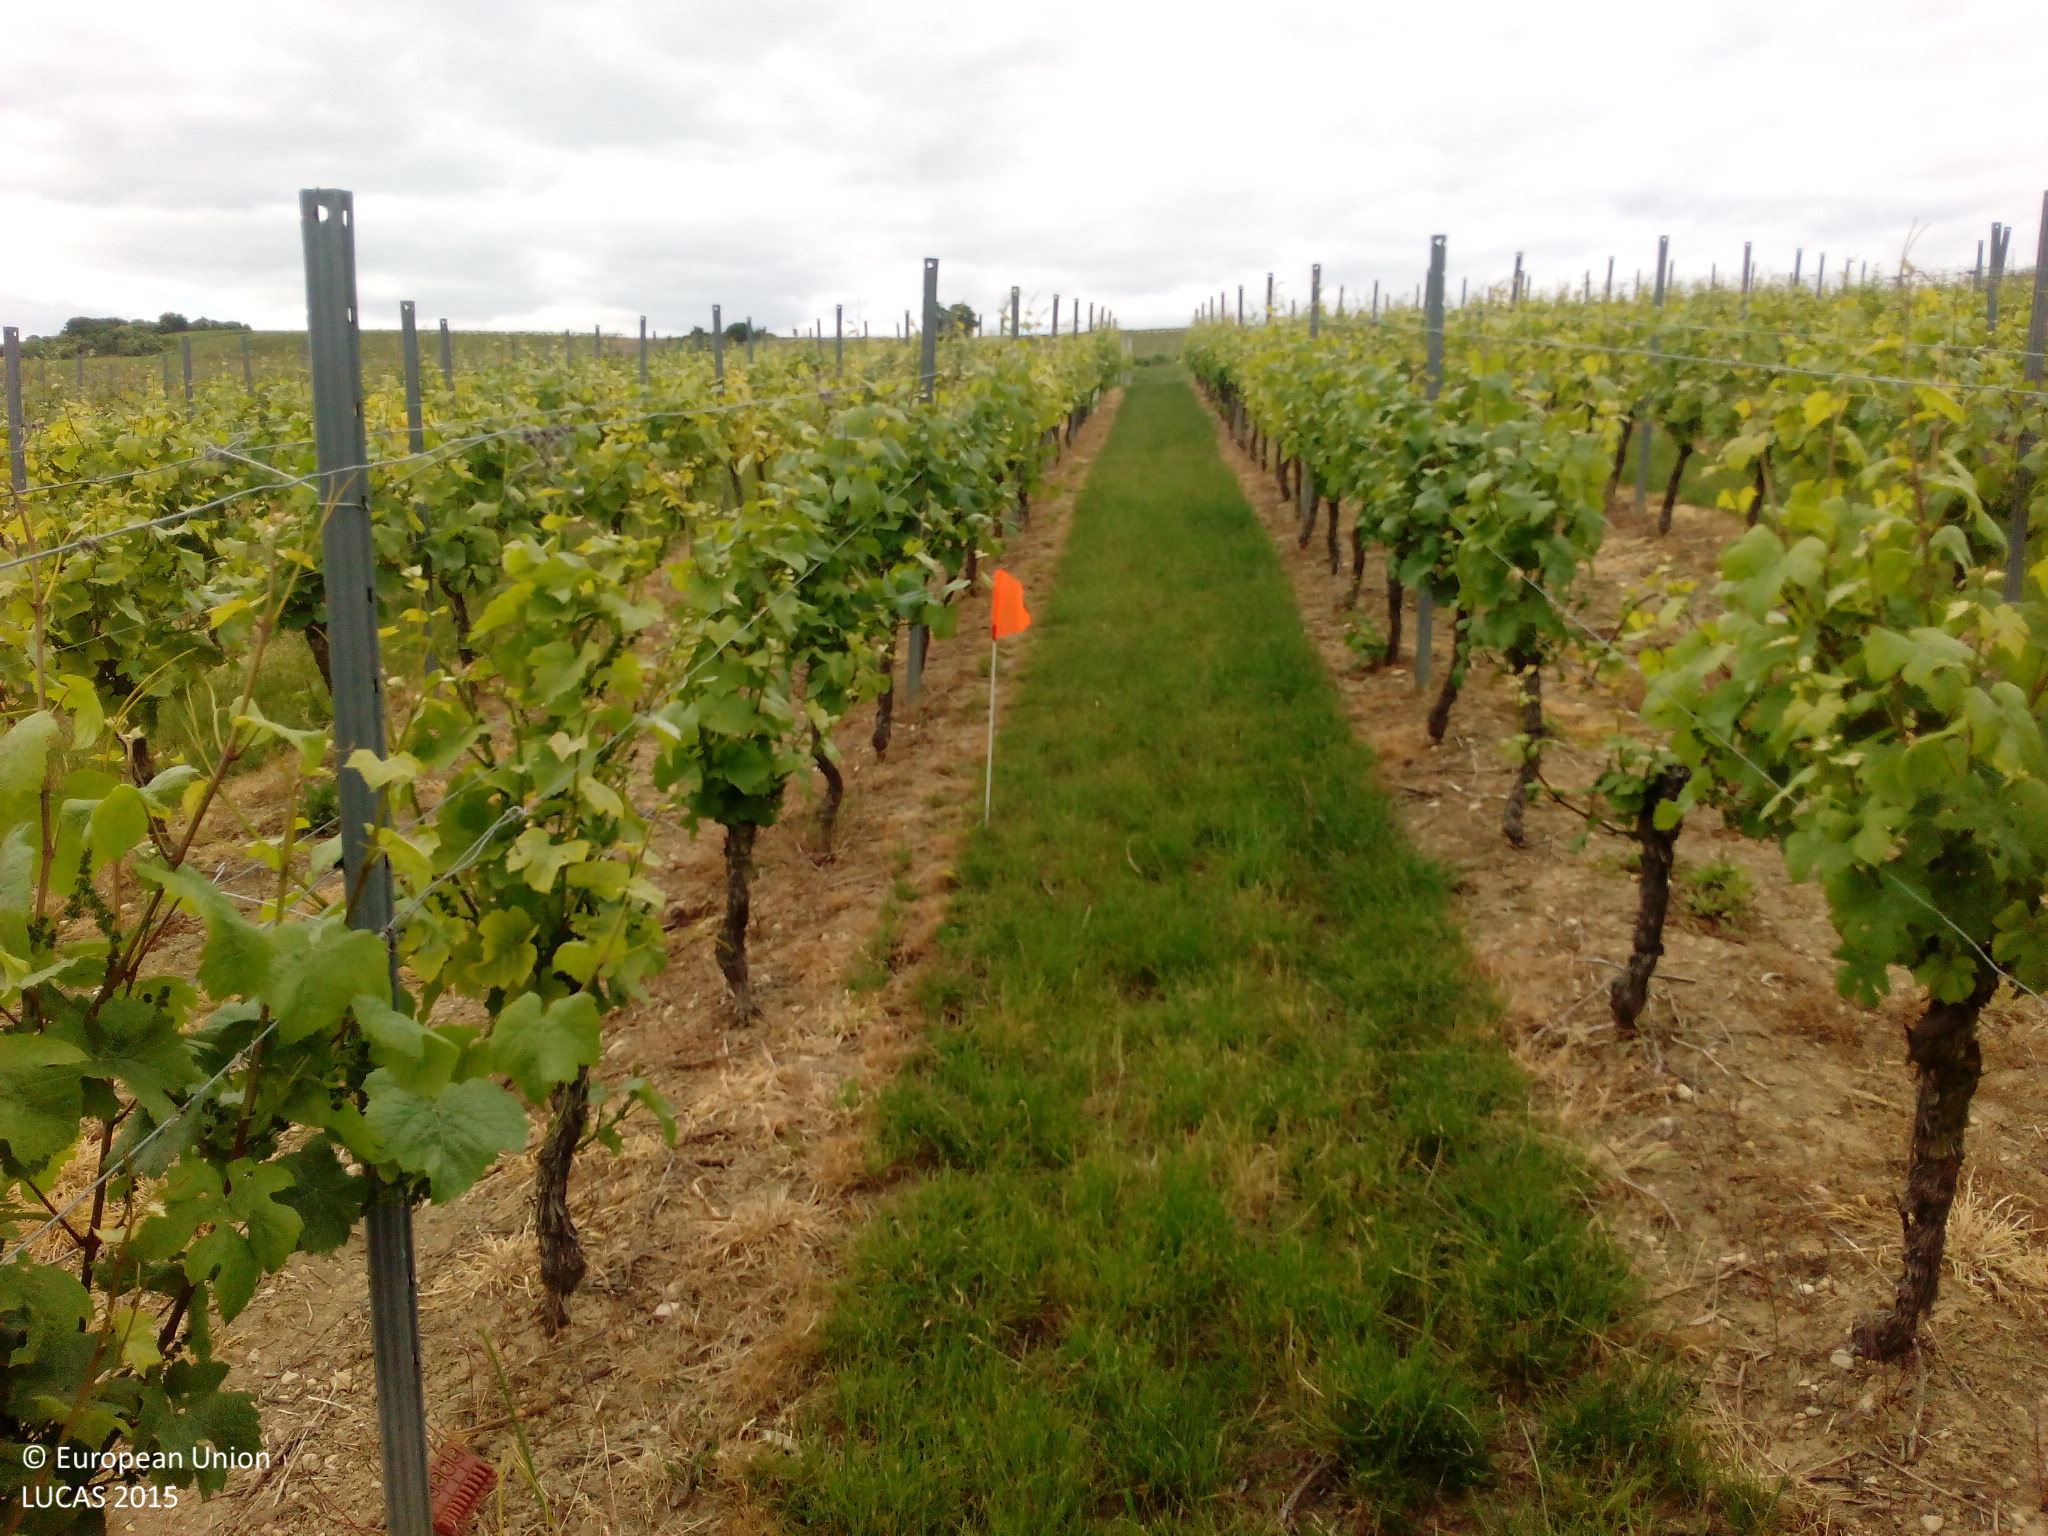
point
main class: Cropland
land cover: Vineyards
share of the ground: 50 - 75 %
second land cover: Grassland without tree/shrub cover
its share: 50 - 75 %
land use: Agriculture (excluding fallow land and kitchen gardens)
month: May
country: DE
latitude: 49.9174
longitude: 8.1481
